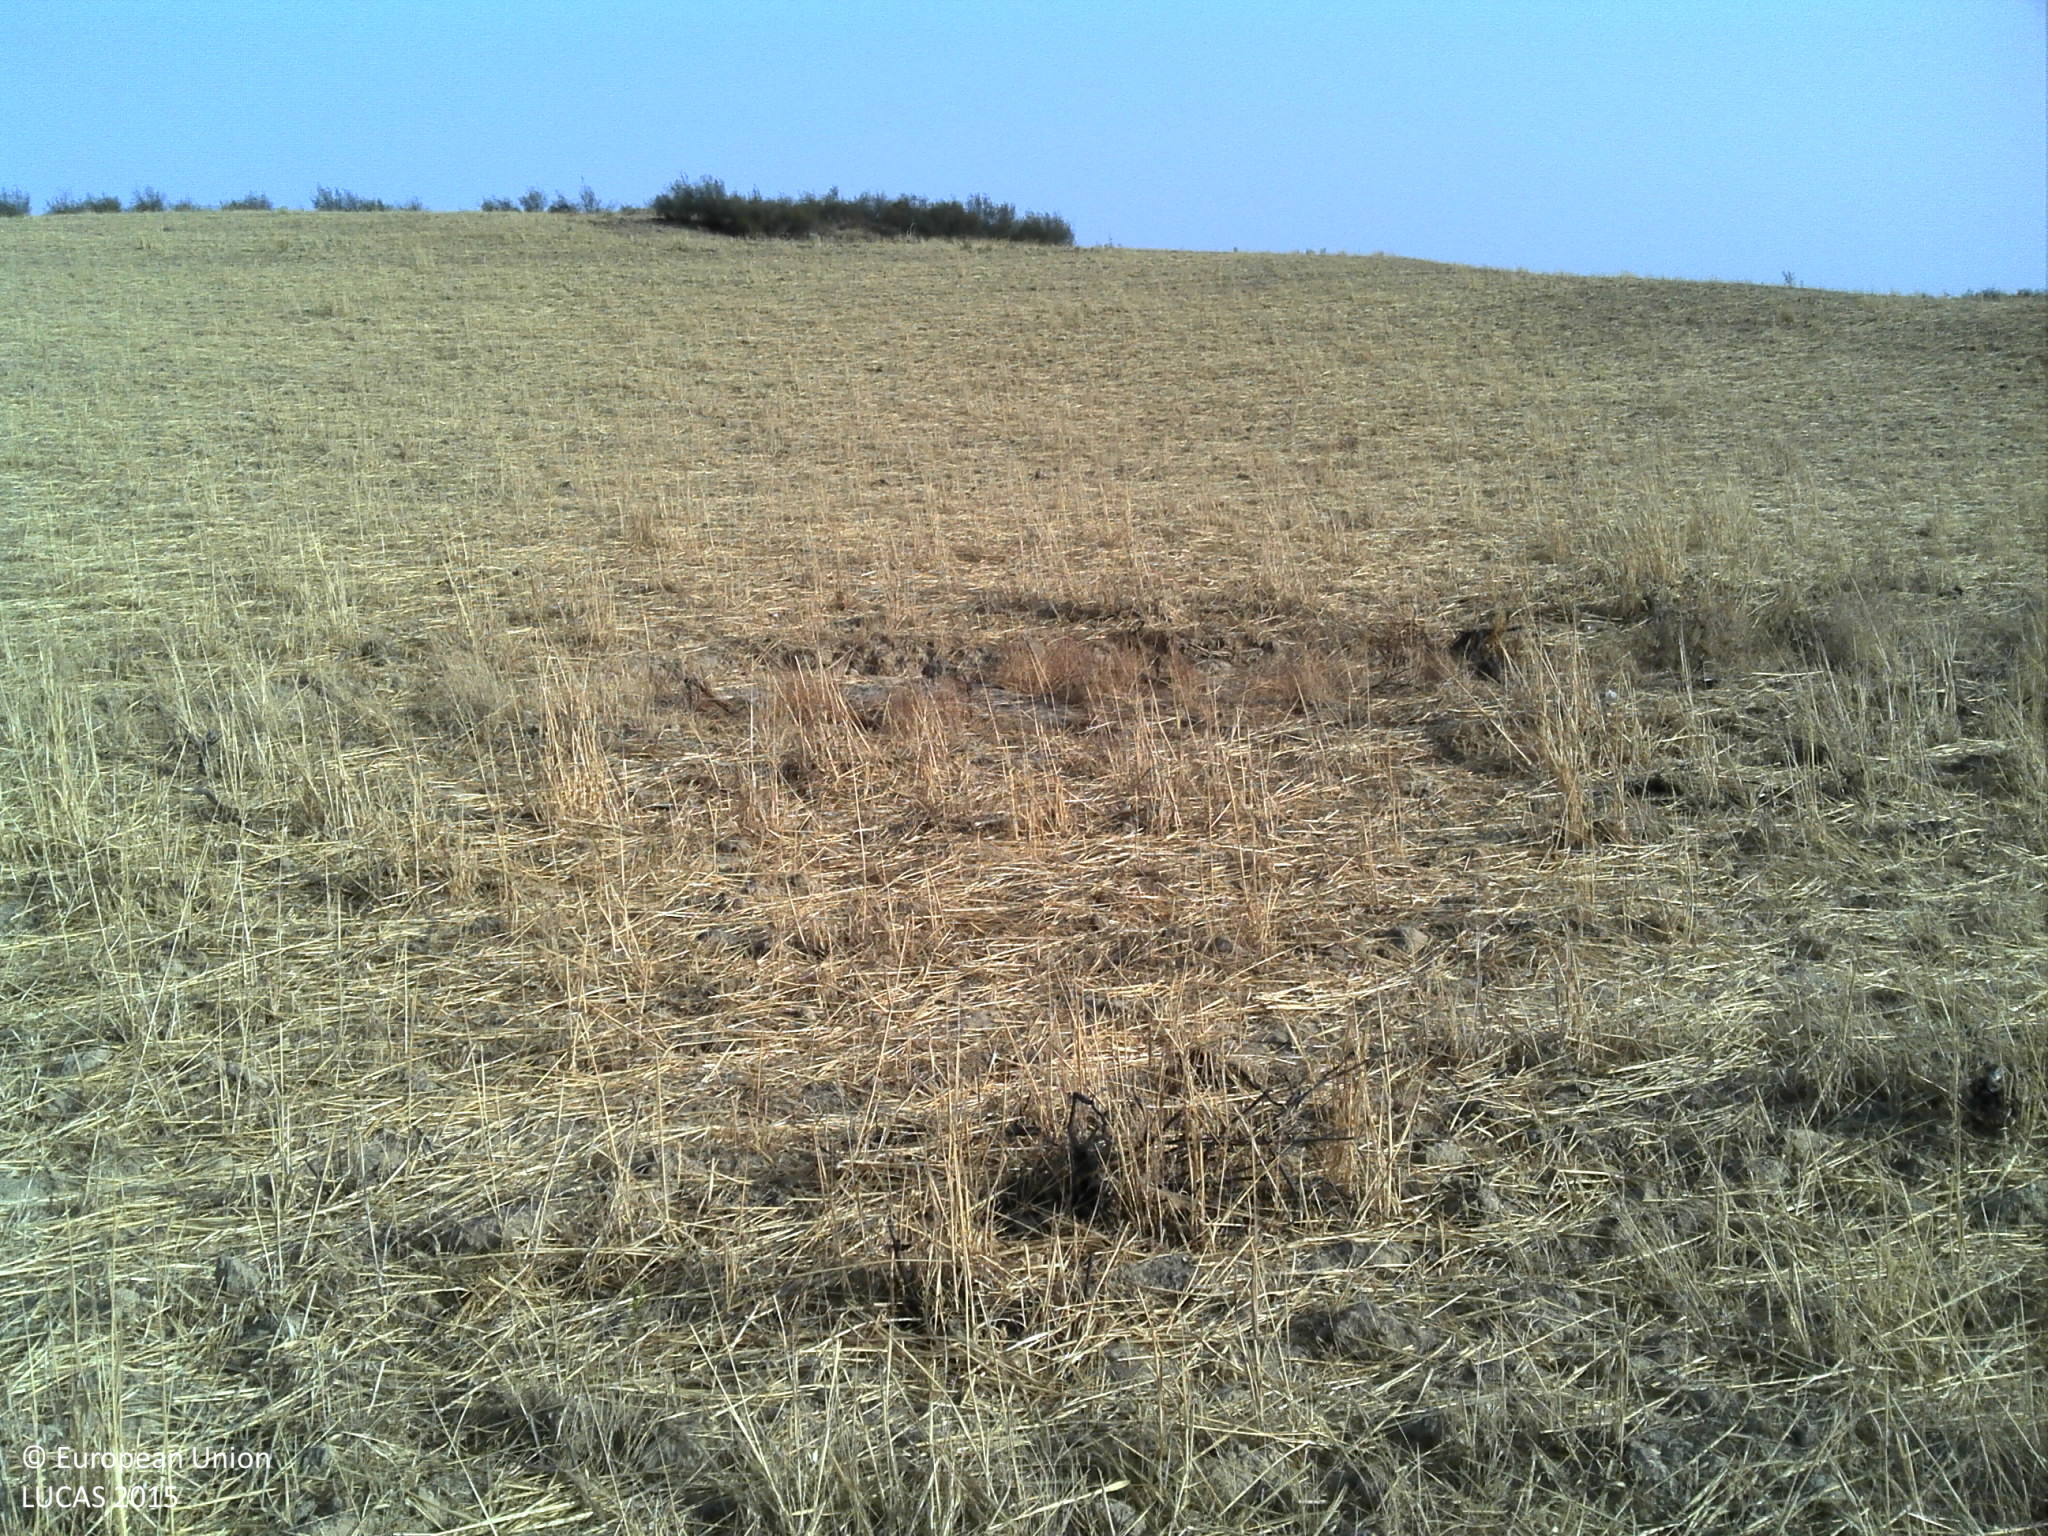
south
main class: Cropland
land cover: Oats
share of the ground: > 75 %
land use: Agriculture (excluding fallow land and kitchen gardens)
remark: Harvested field
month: July
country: PT
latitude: 37.5273
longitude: -7.9321
